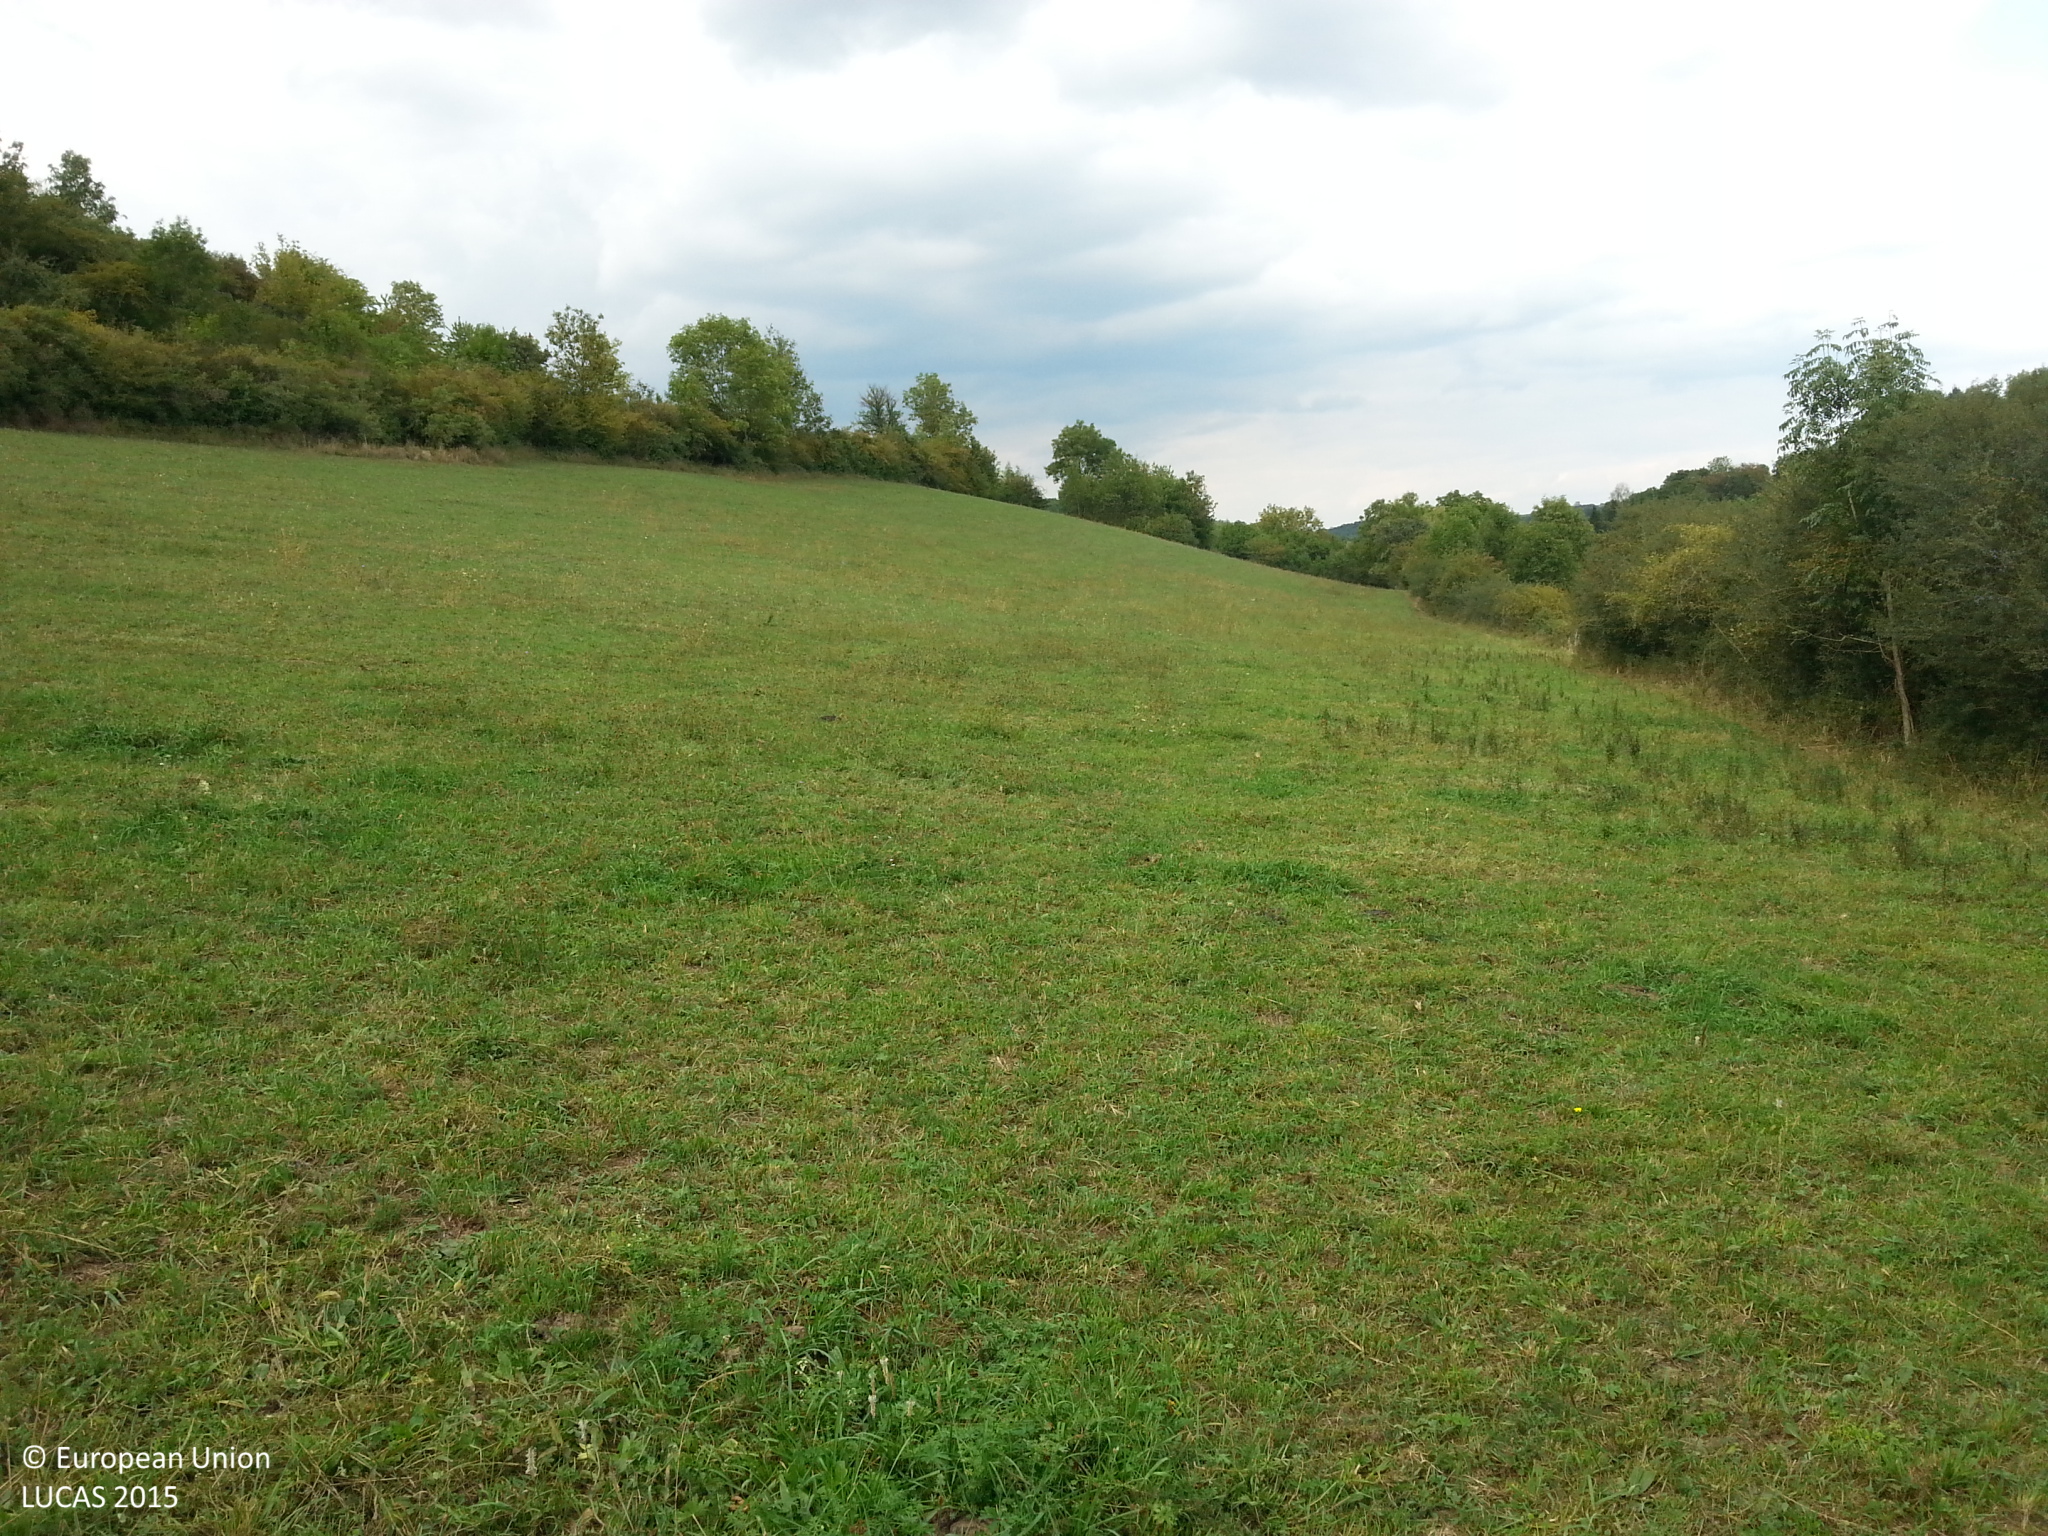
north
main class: Grassland
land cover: Grassland without tree/shrub cover
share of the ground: > 75 %
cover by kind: herbaceous plants 100 %
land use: Agriculture (excluding fallow land and kitchen gardens)
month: September
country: DE
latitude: 49.3929
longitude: 9.9036
